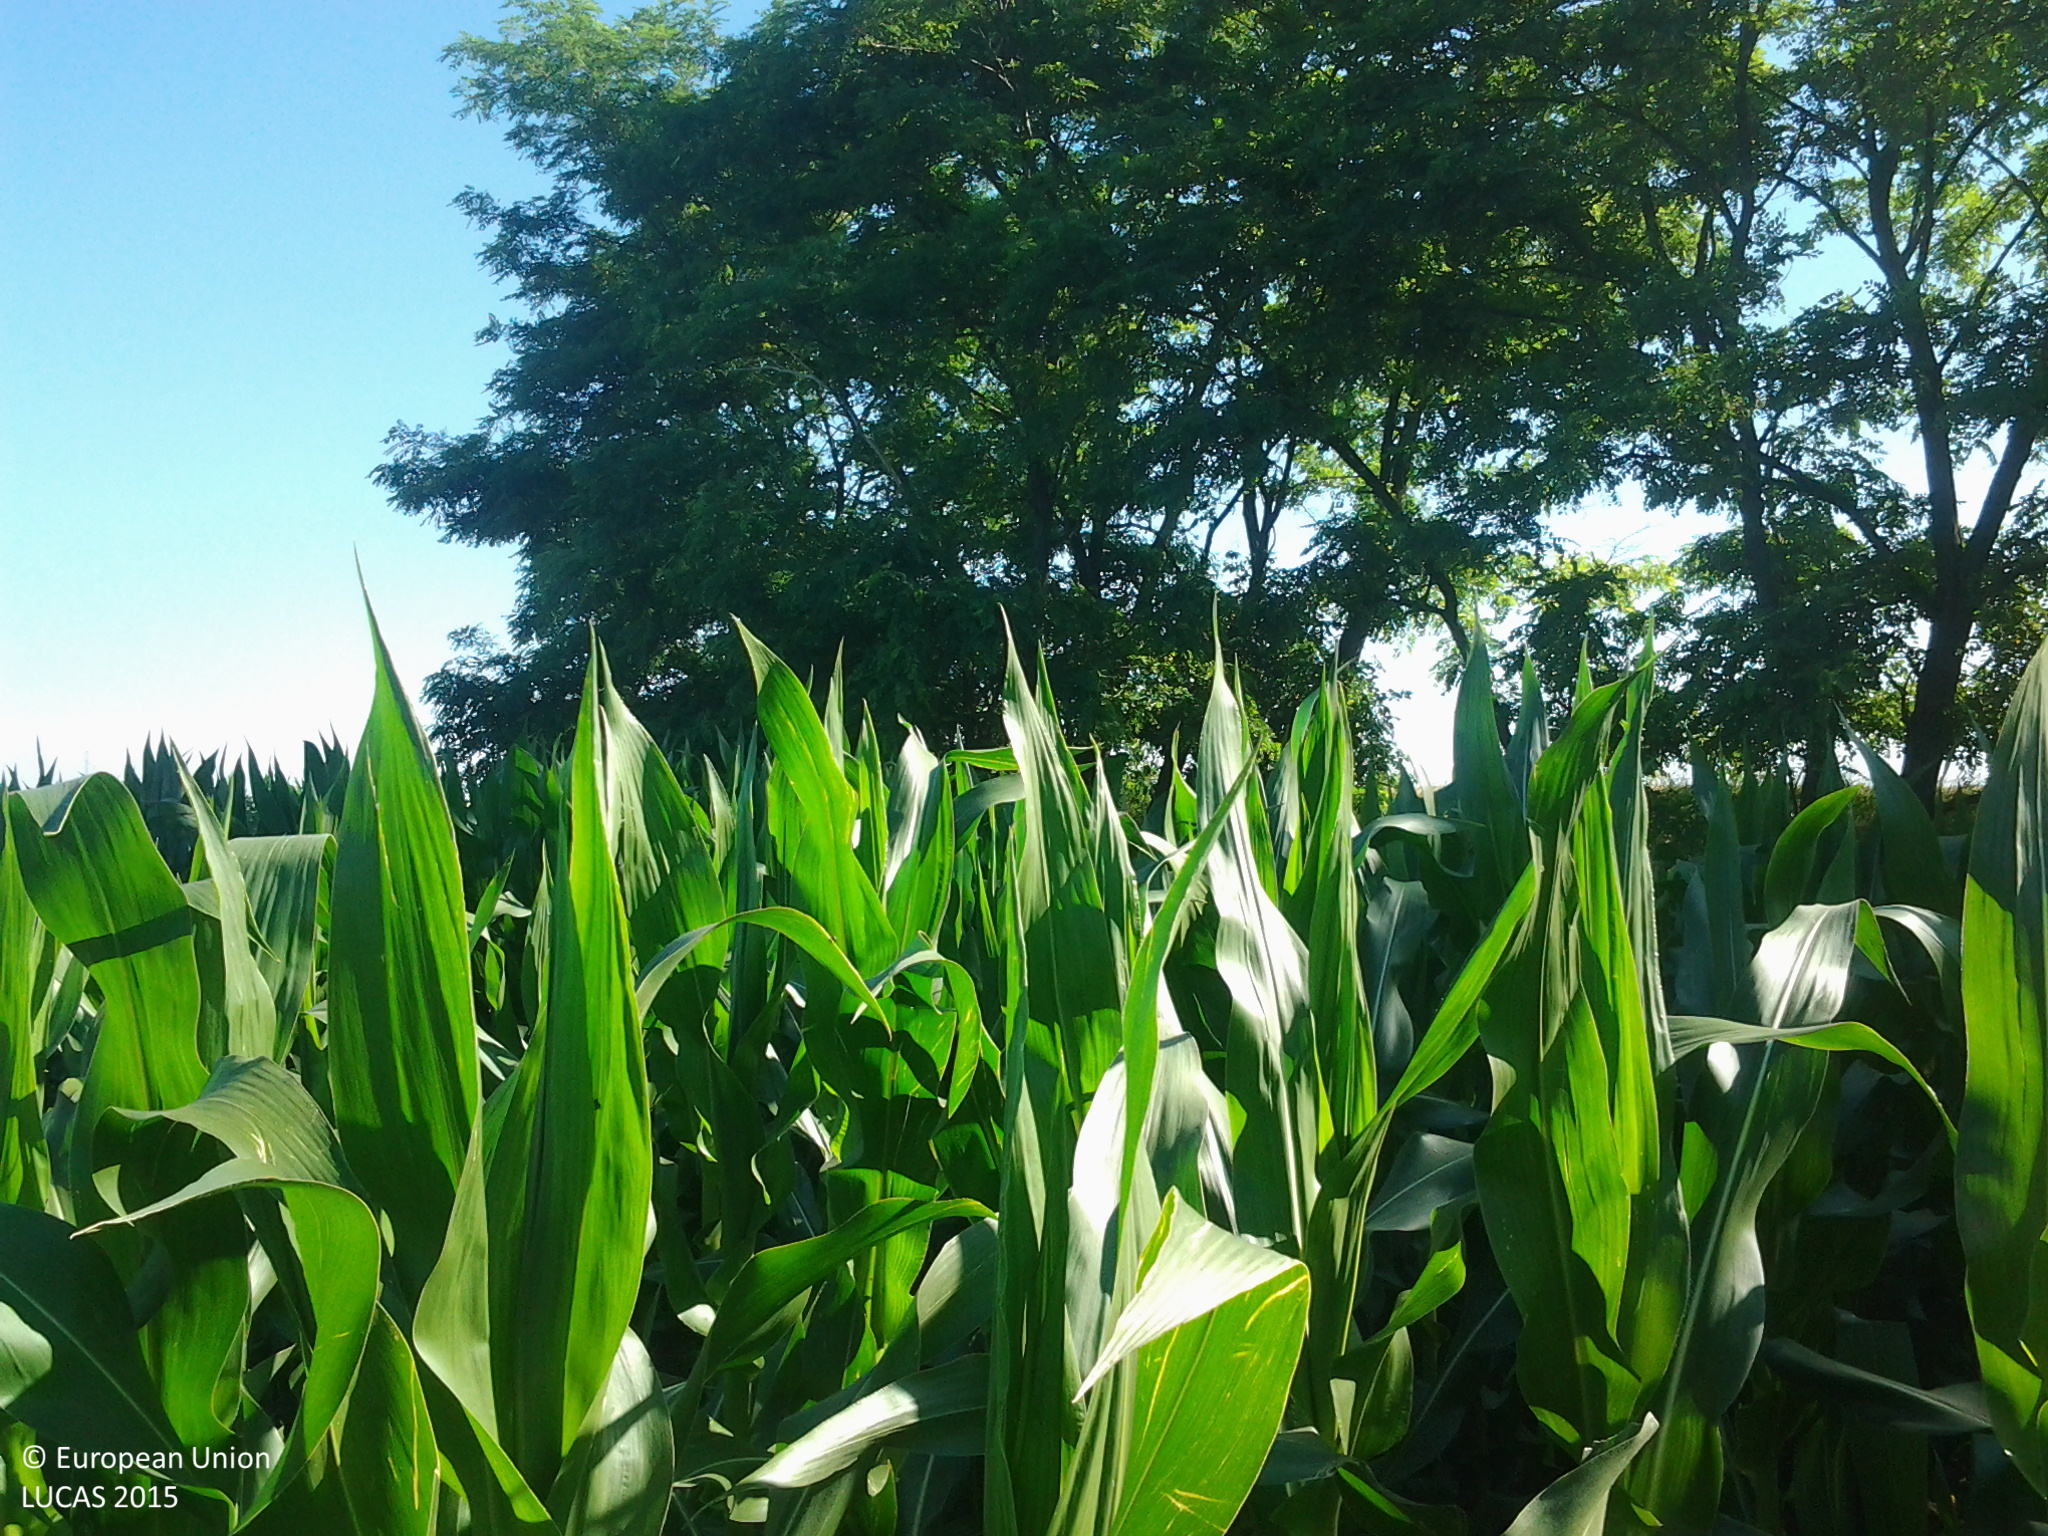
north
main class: Cropland
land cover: Maize
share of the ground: > 75 %
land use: Agriculture (excluding fallow land and kitchen gardens)
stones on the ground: < 10 %
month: June
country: HU
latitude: 46.9652
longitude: 19.6542
